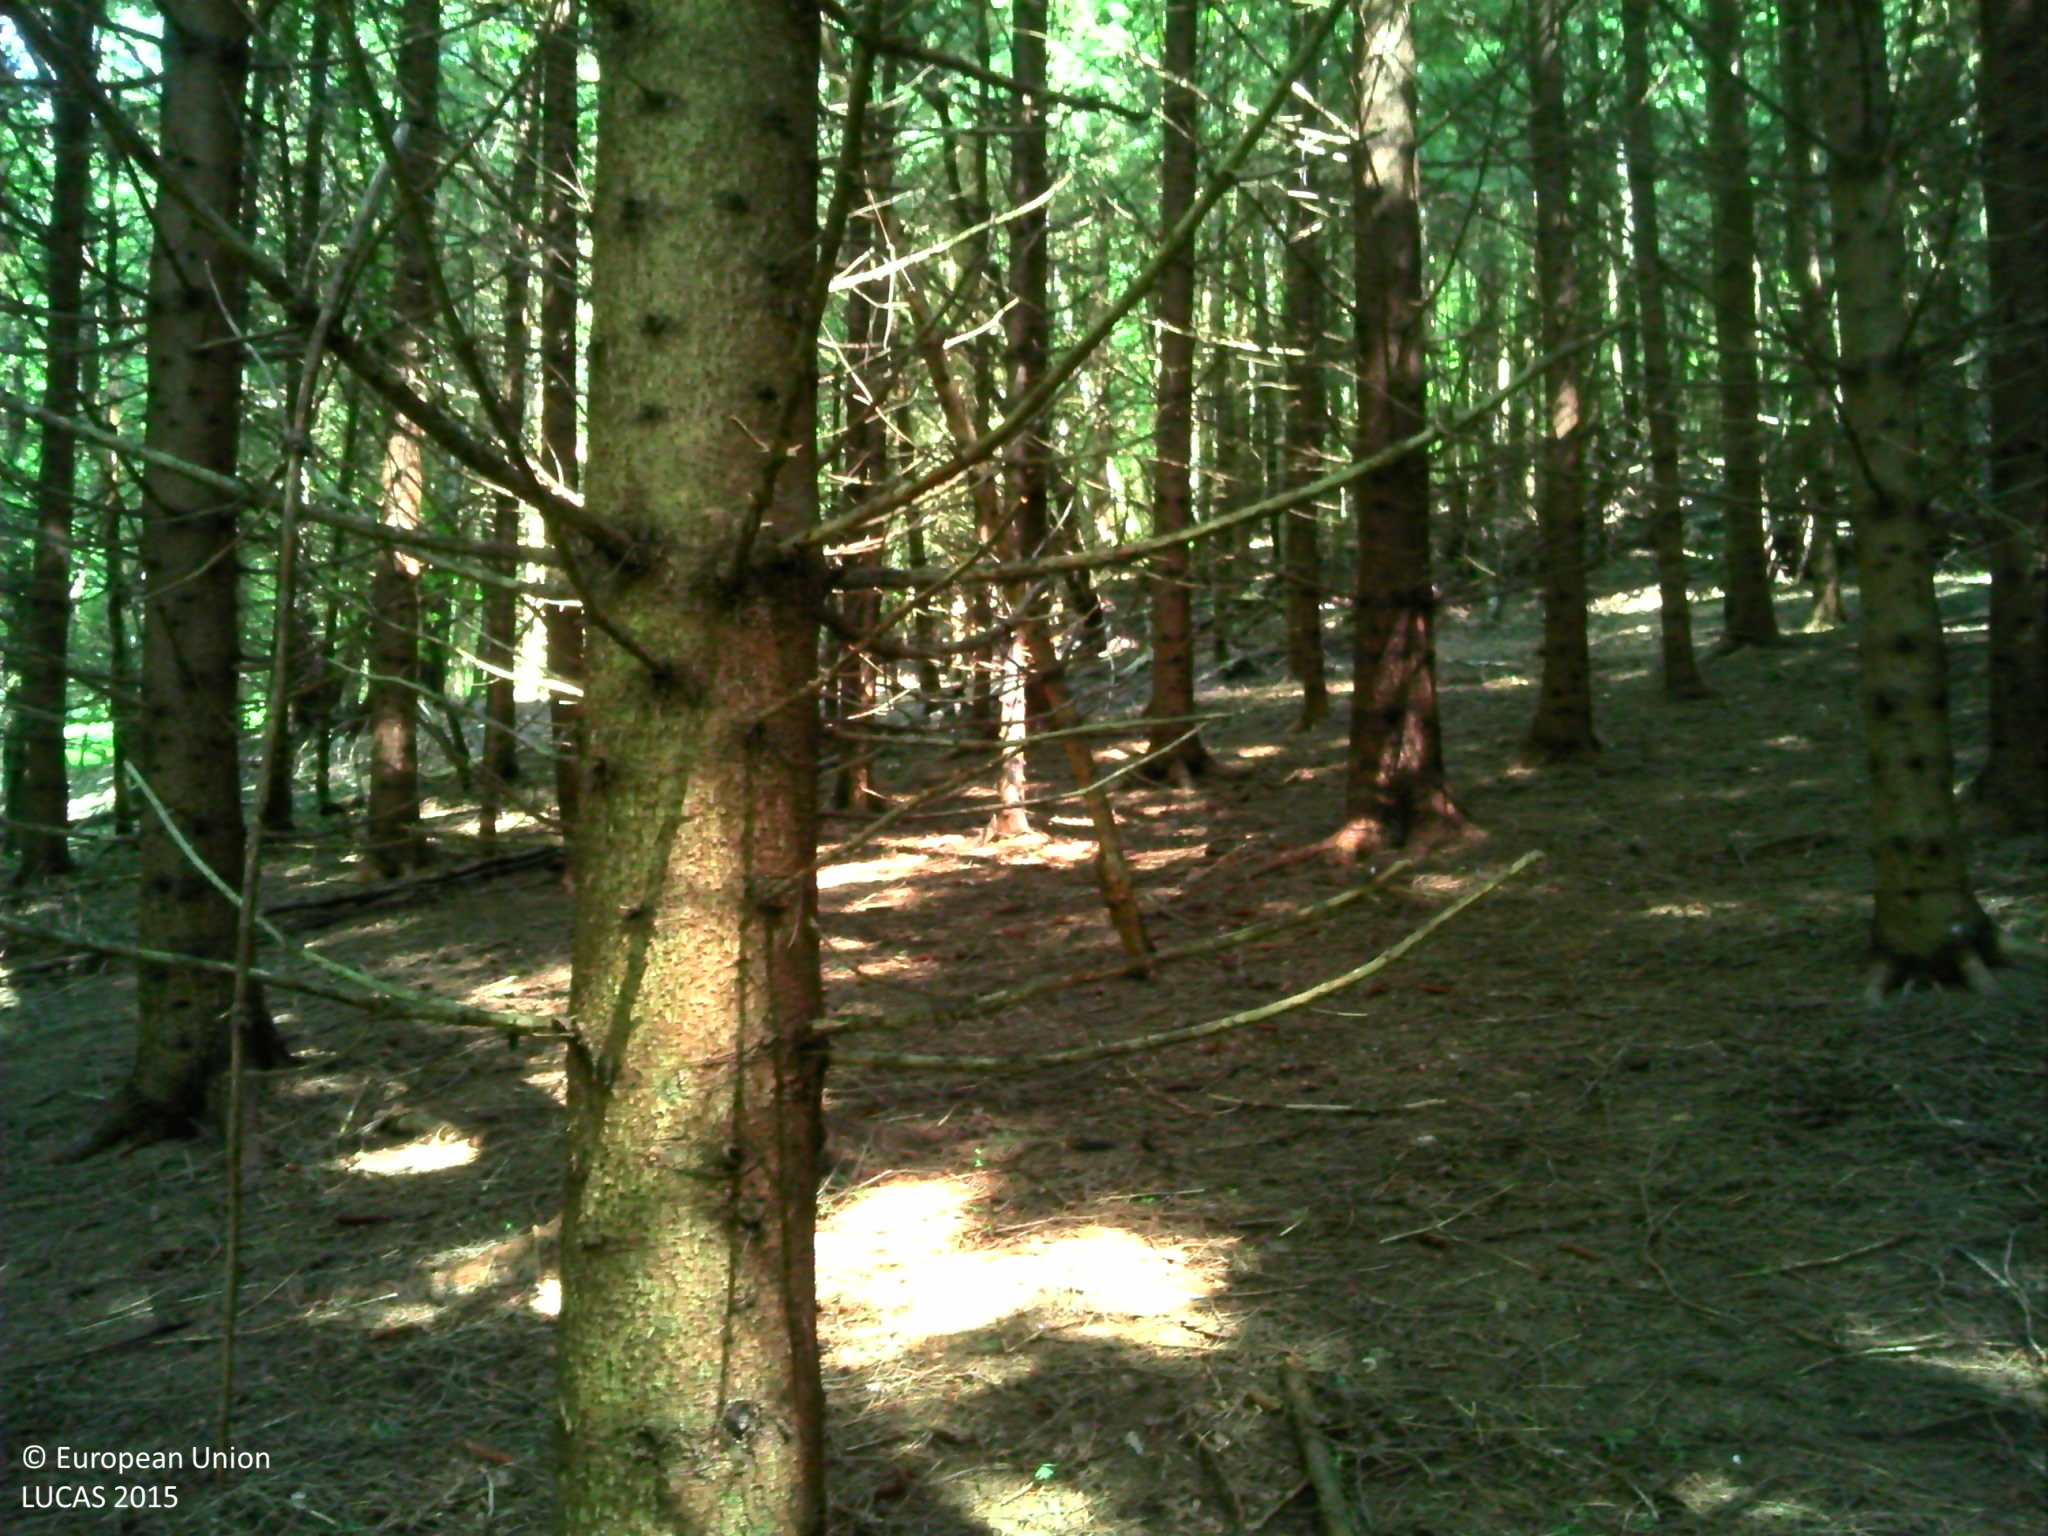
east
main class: Woodland
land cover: Spruce dominated coniferous woodland
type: alpine coniferous forest
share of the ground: > 75 %
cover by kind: coniferous forest trees 100 %
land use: Forestry
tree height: > 5 m
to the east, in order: Spruce dominated coniferous woodland; Broadleaved woodland; Spruce dominated coniferous woodland
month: June
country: FR
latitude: 45.4894
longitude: 6.1789
